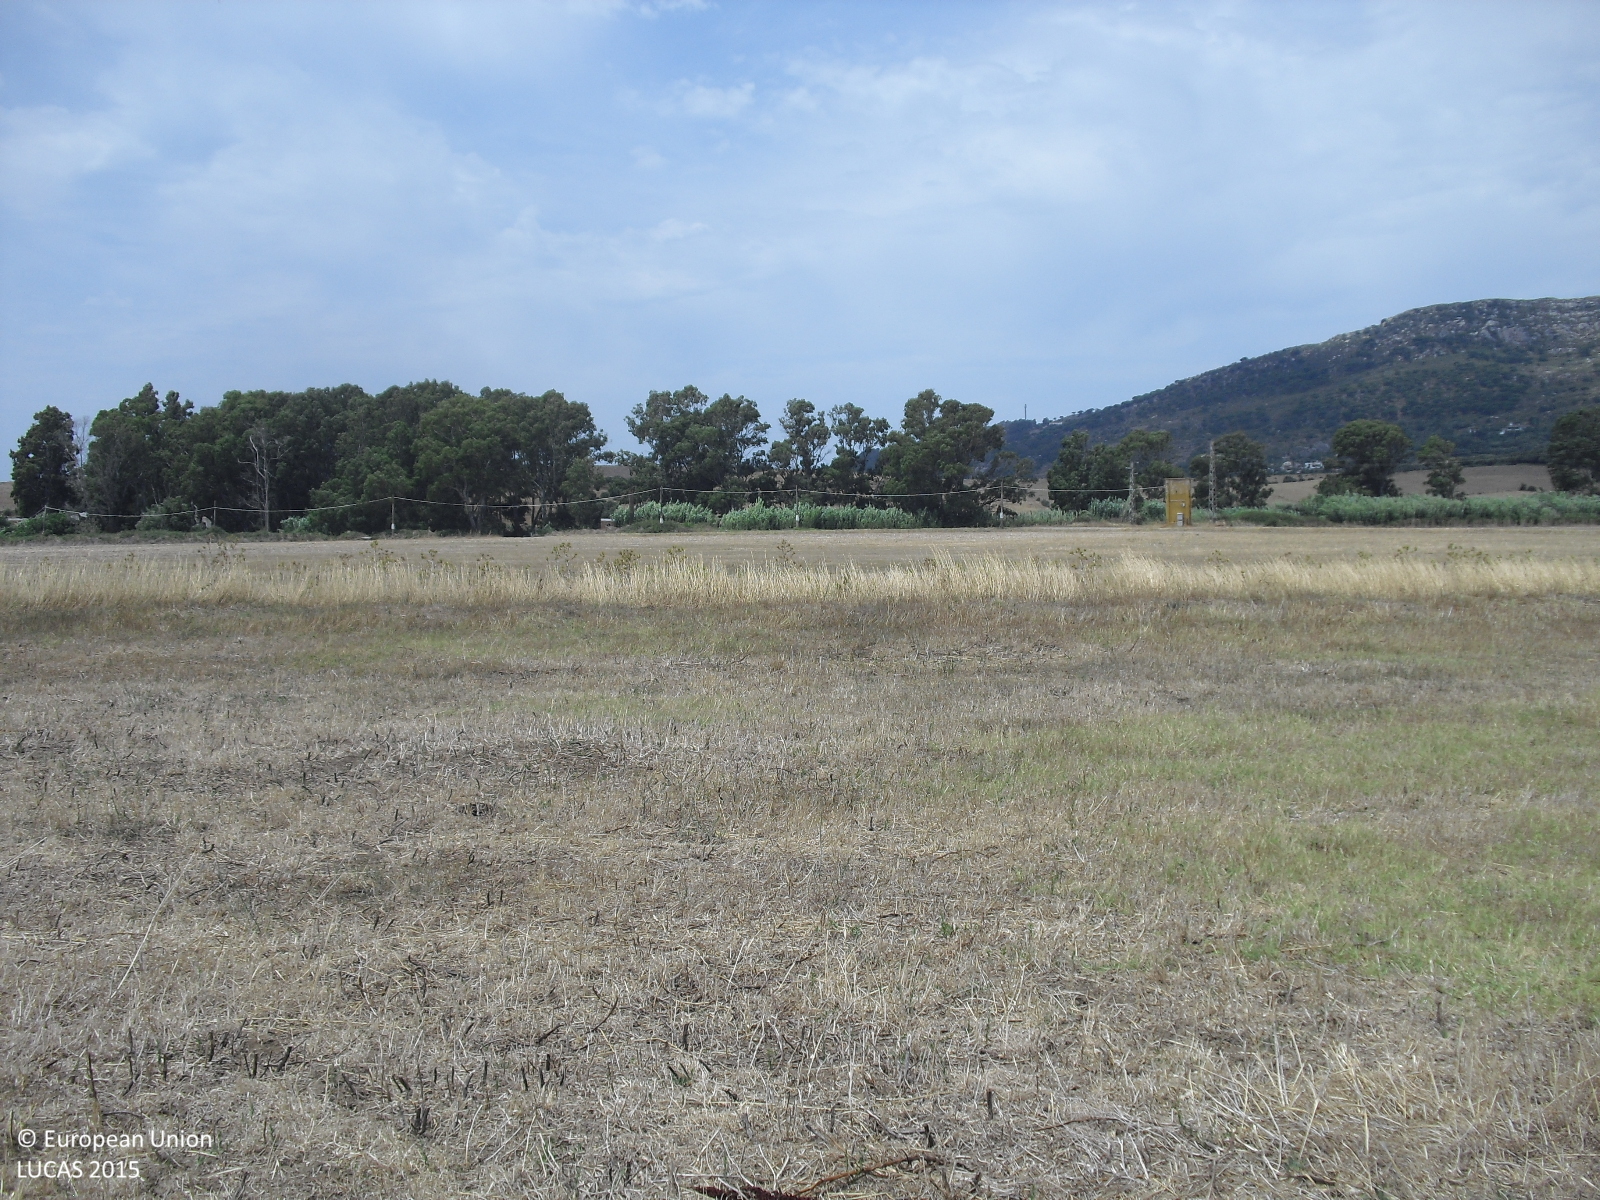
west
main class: Grassland
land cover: Spontaneously vegetated surfaces
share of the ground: 25 - 50 %
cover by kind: unconsolidated bare surface 65 %, herbaceous plants 35 %
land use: Agriculture (excluding fallow land and kitchen gardens)
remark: Harvested field
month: July
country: ES
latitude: 36.0585
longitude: -5.6344
